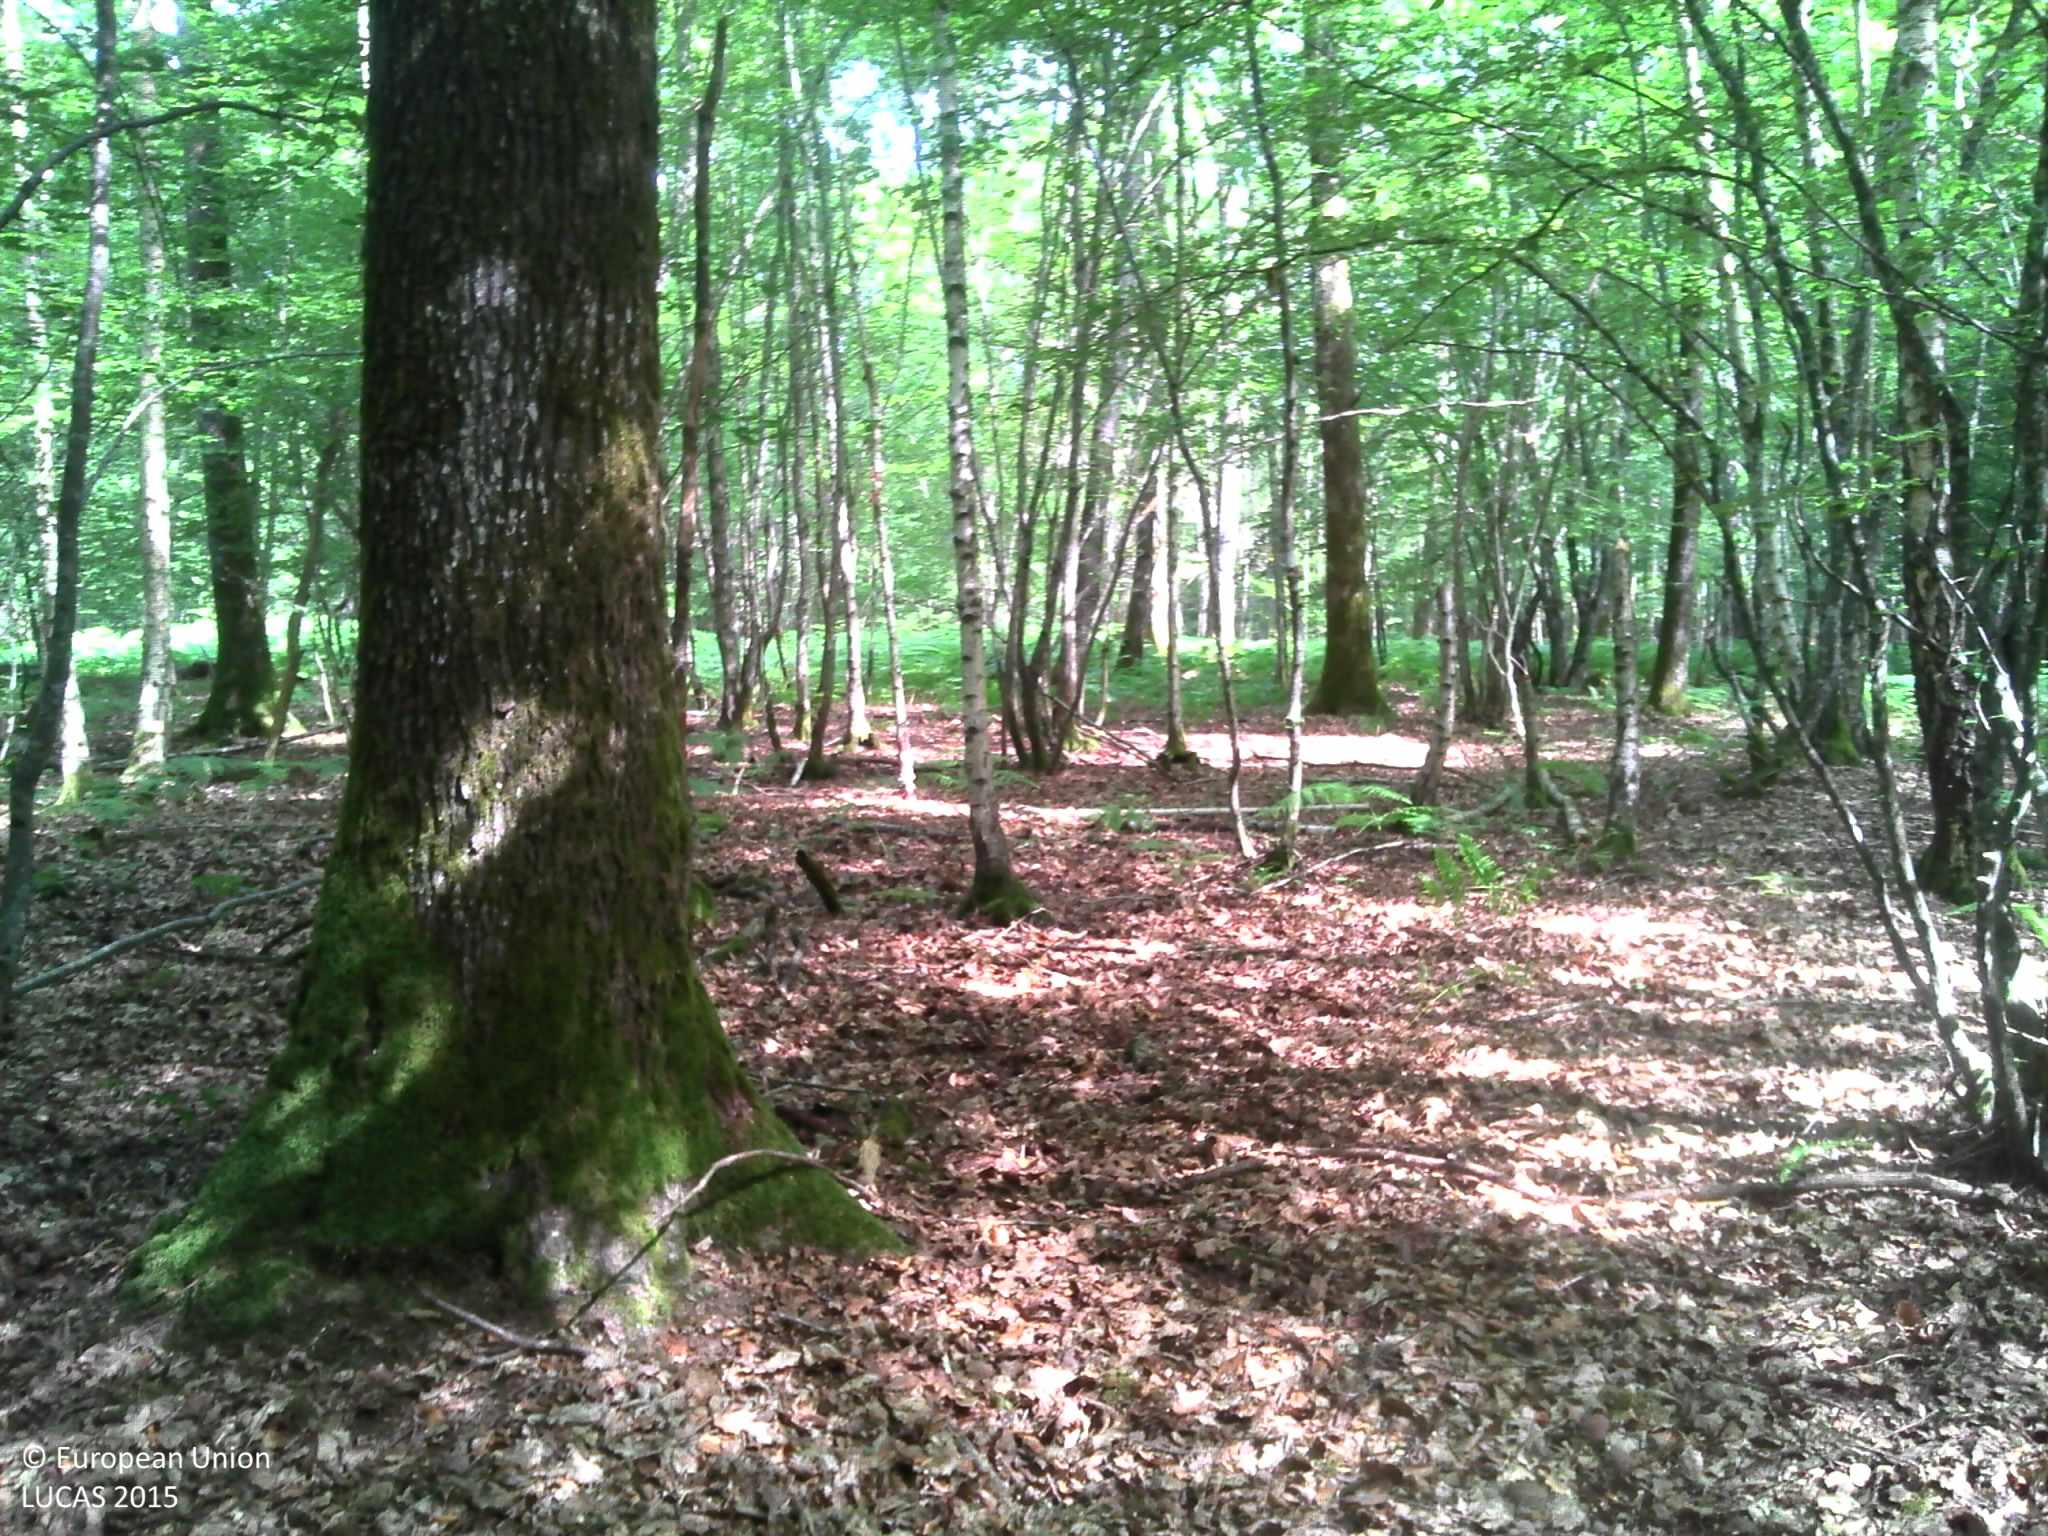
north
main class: Woodland
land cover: Broadleaved woodland
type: mesophytic deciduous forest
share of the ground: > 75 %
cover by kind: broadleaved forest trees 90 %, herbaceous plants 5 %, lichens and mosses 5 %
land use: Forestry
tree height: > 5 m
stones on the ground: < 10 %
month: June
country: FR
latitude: 48.0686
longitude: 3.5129
